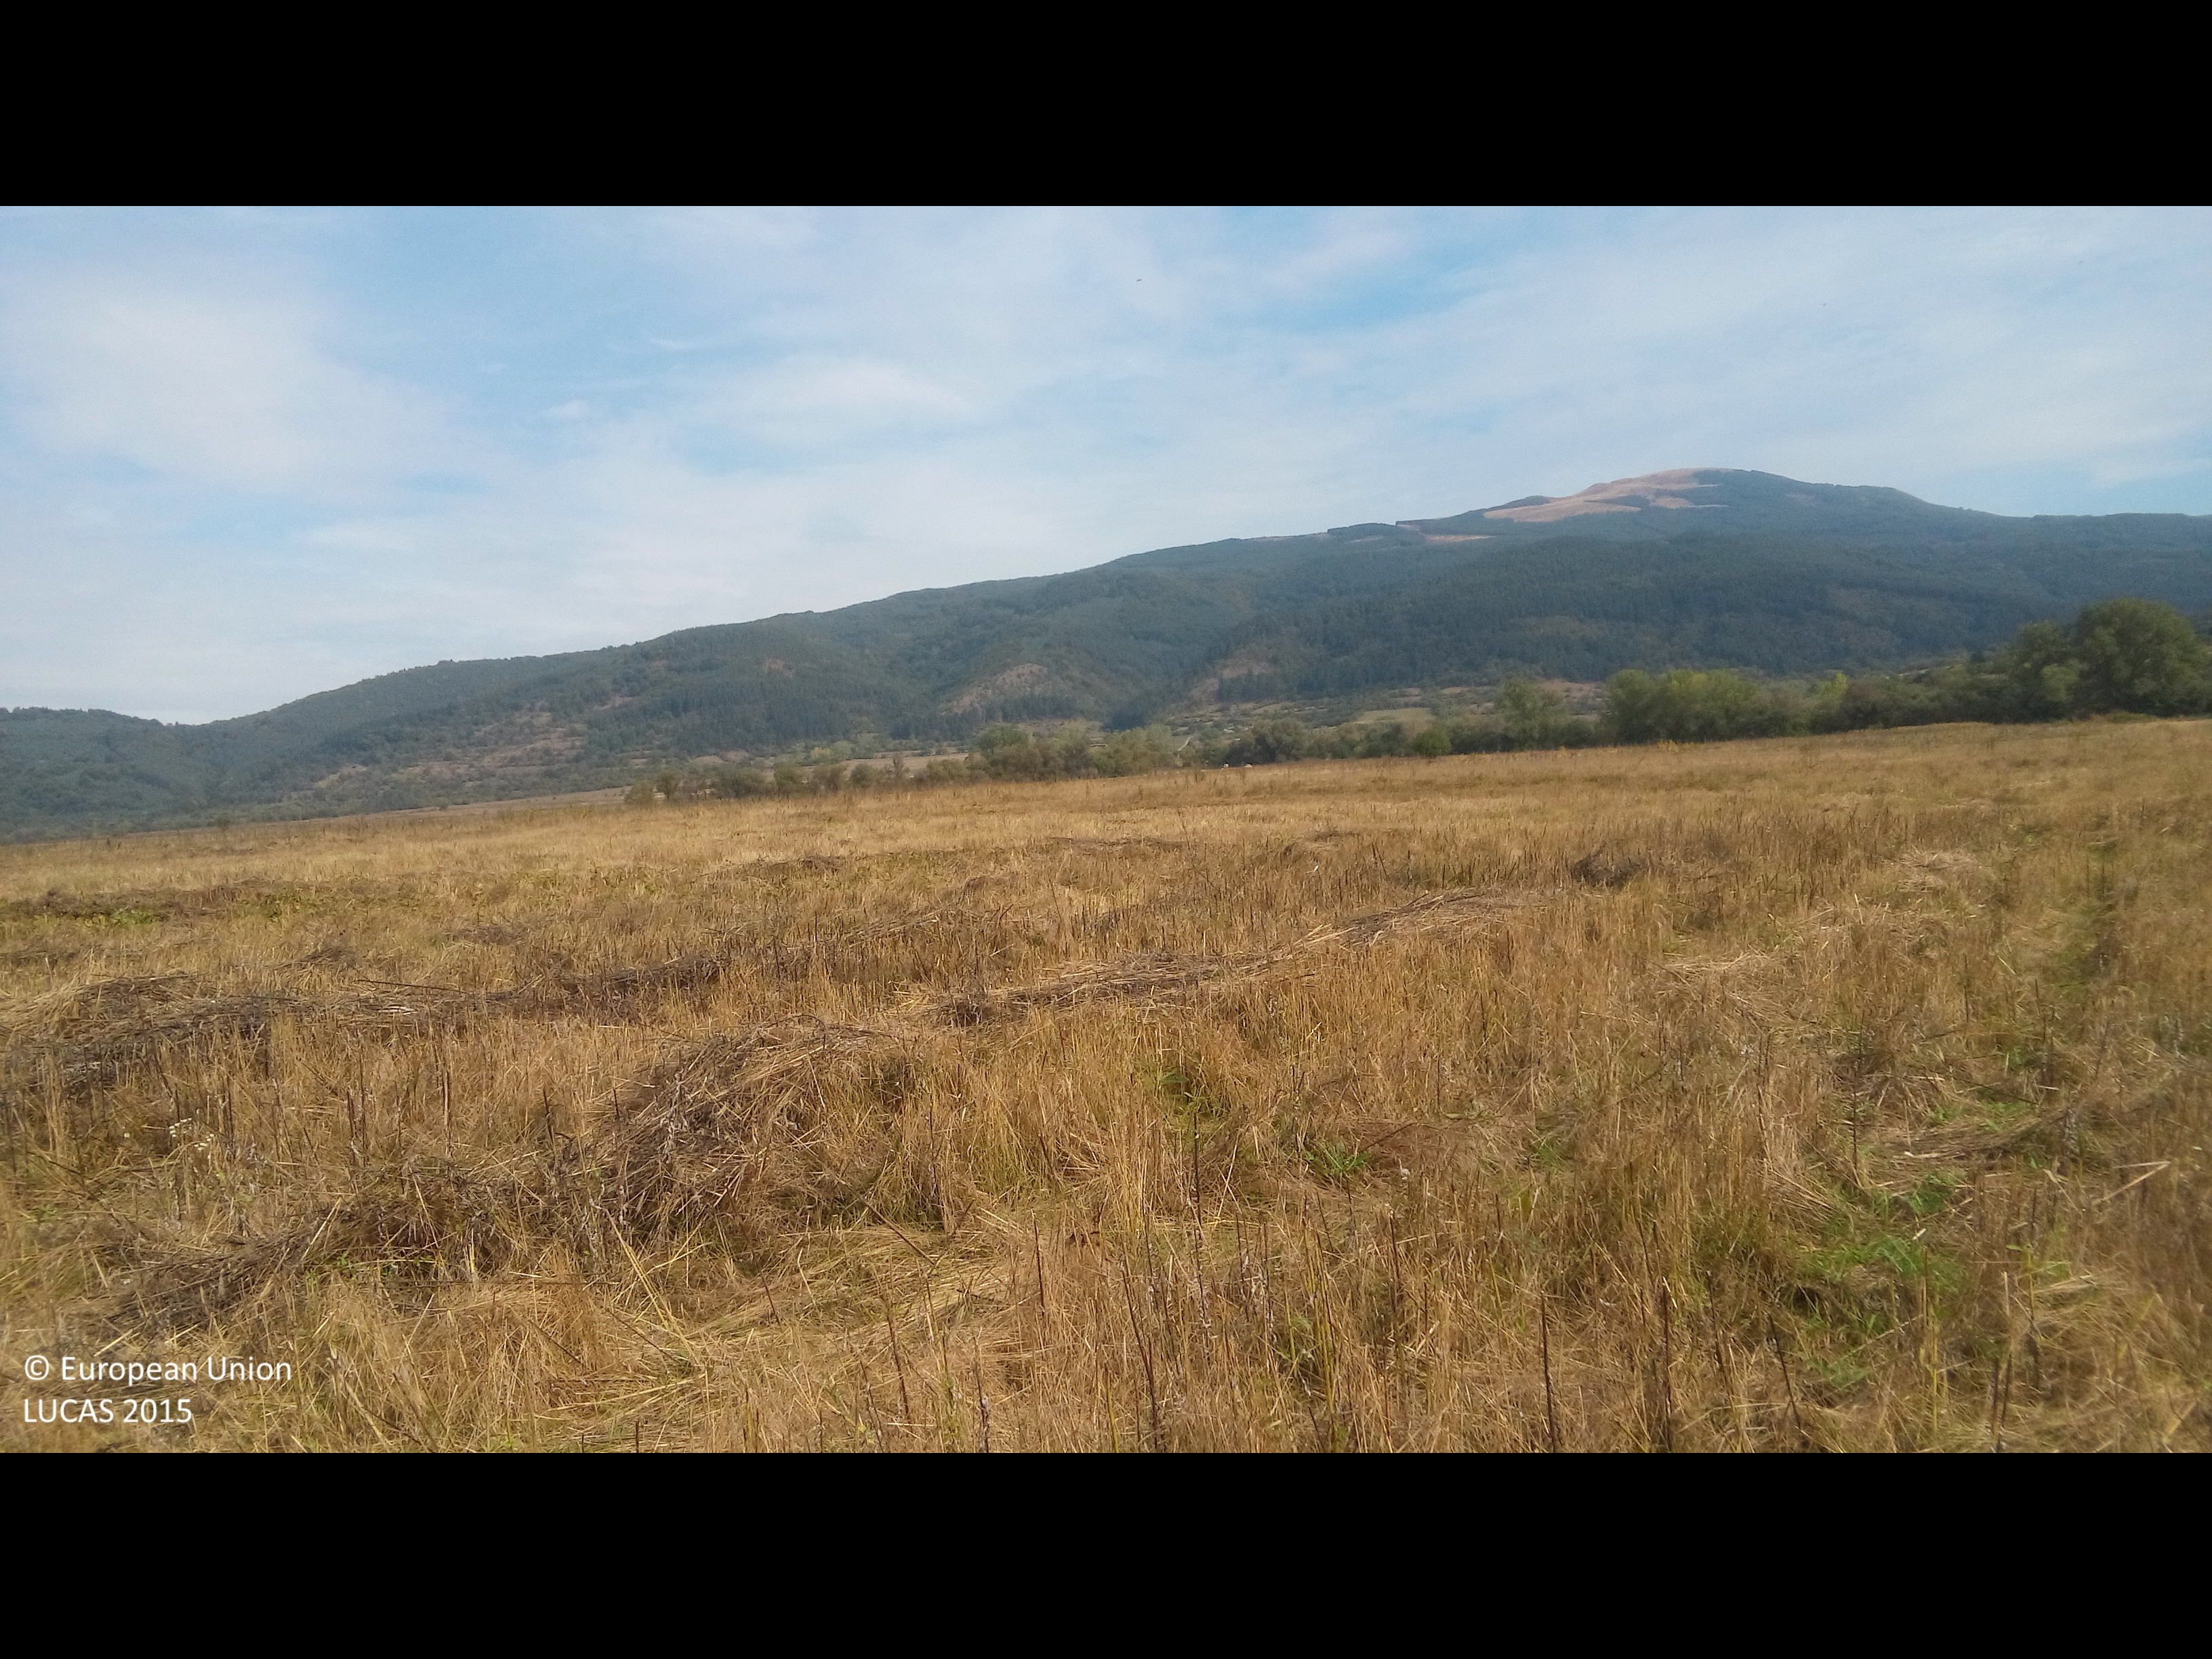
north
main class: Cropland
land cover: Common wheat
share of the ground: 50 - 75 %
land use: Agriculture (excluding fallow land and kitchen gardens)
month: October
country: BG
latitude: 42.7390
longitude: 23.8582
